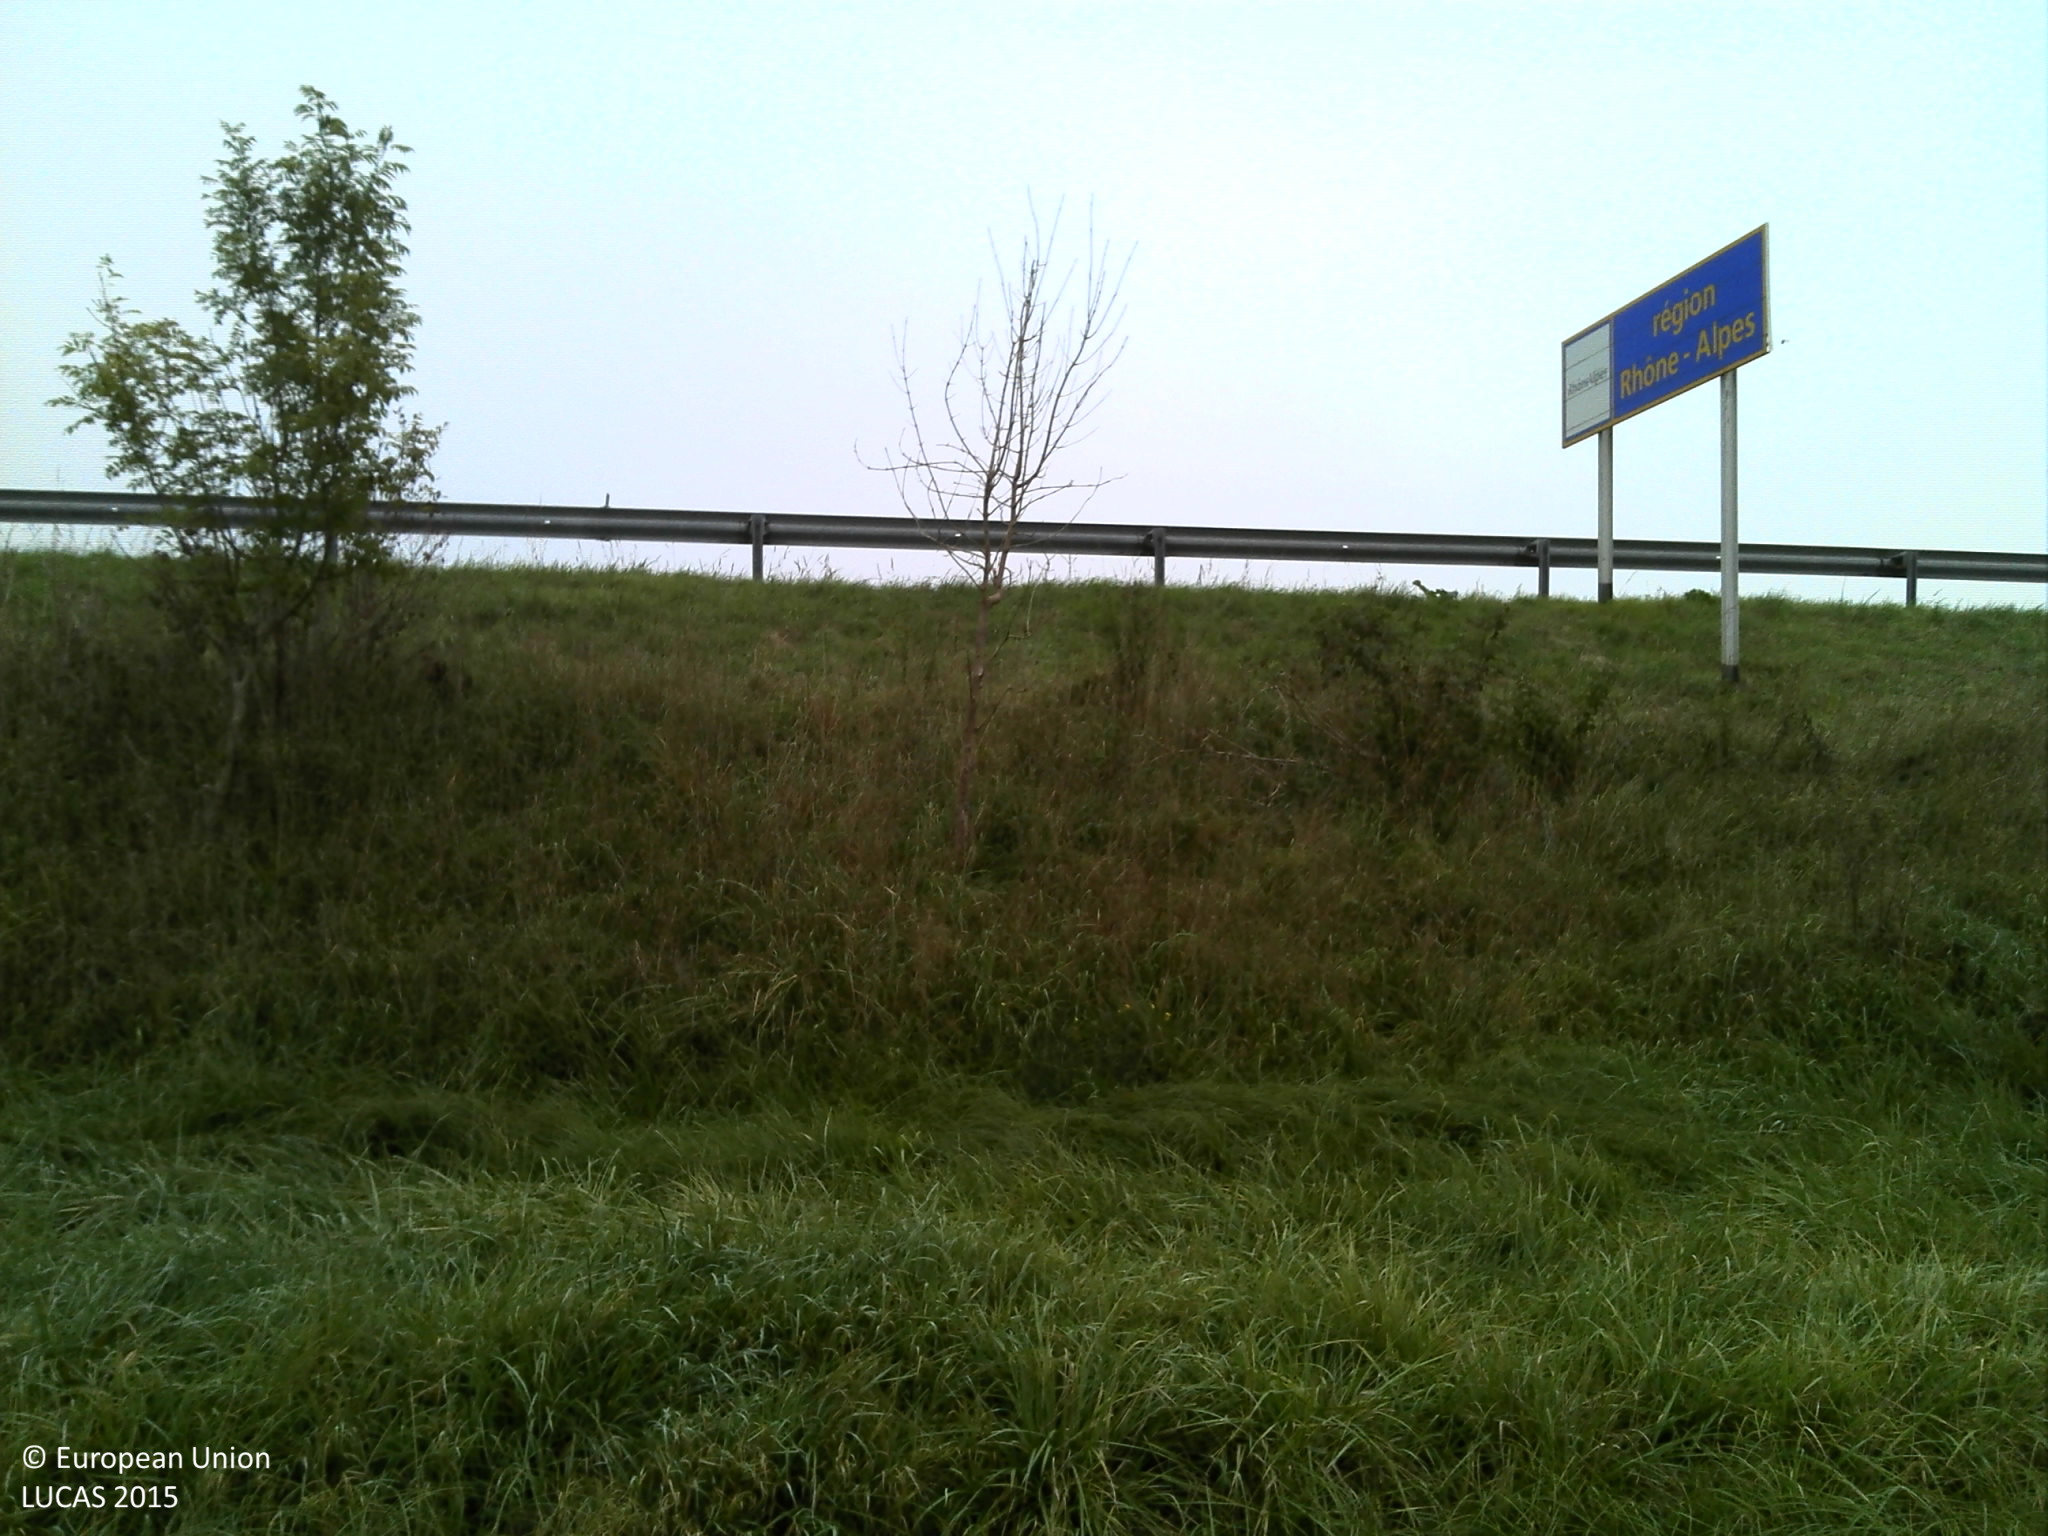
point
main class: Grassland
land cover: Grassland without tree/shrub cover
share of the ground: > 75 %
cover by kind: herbaceous plants 100 %
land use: Road transport
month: October
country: FR
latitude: 46.4454
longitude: 5.2773
